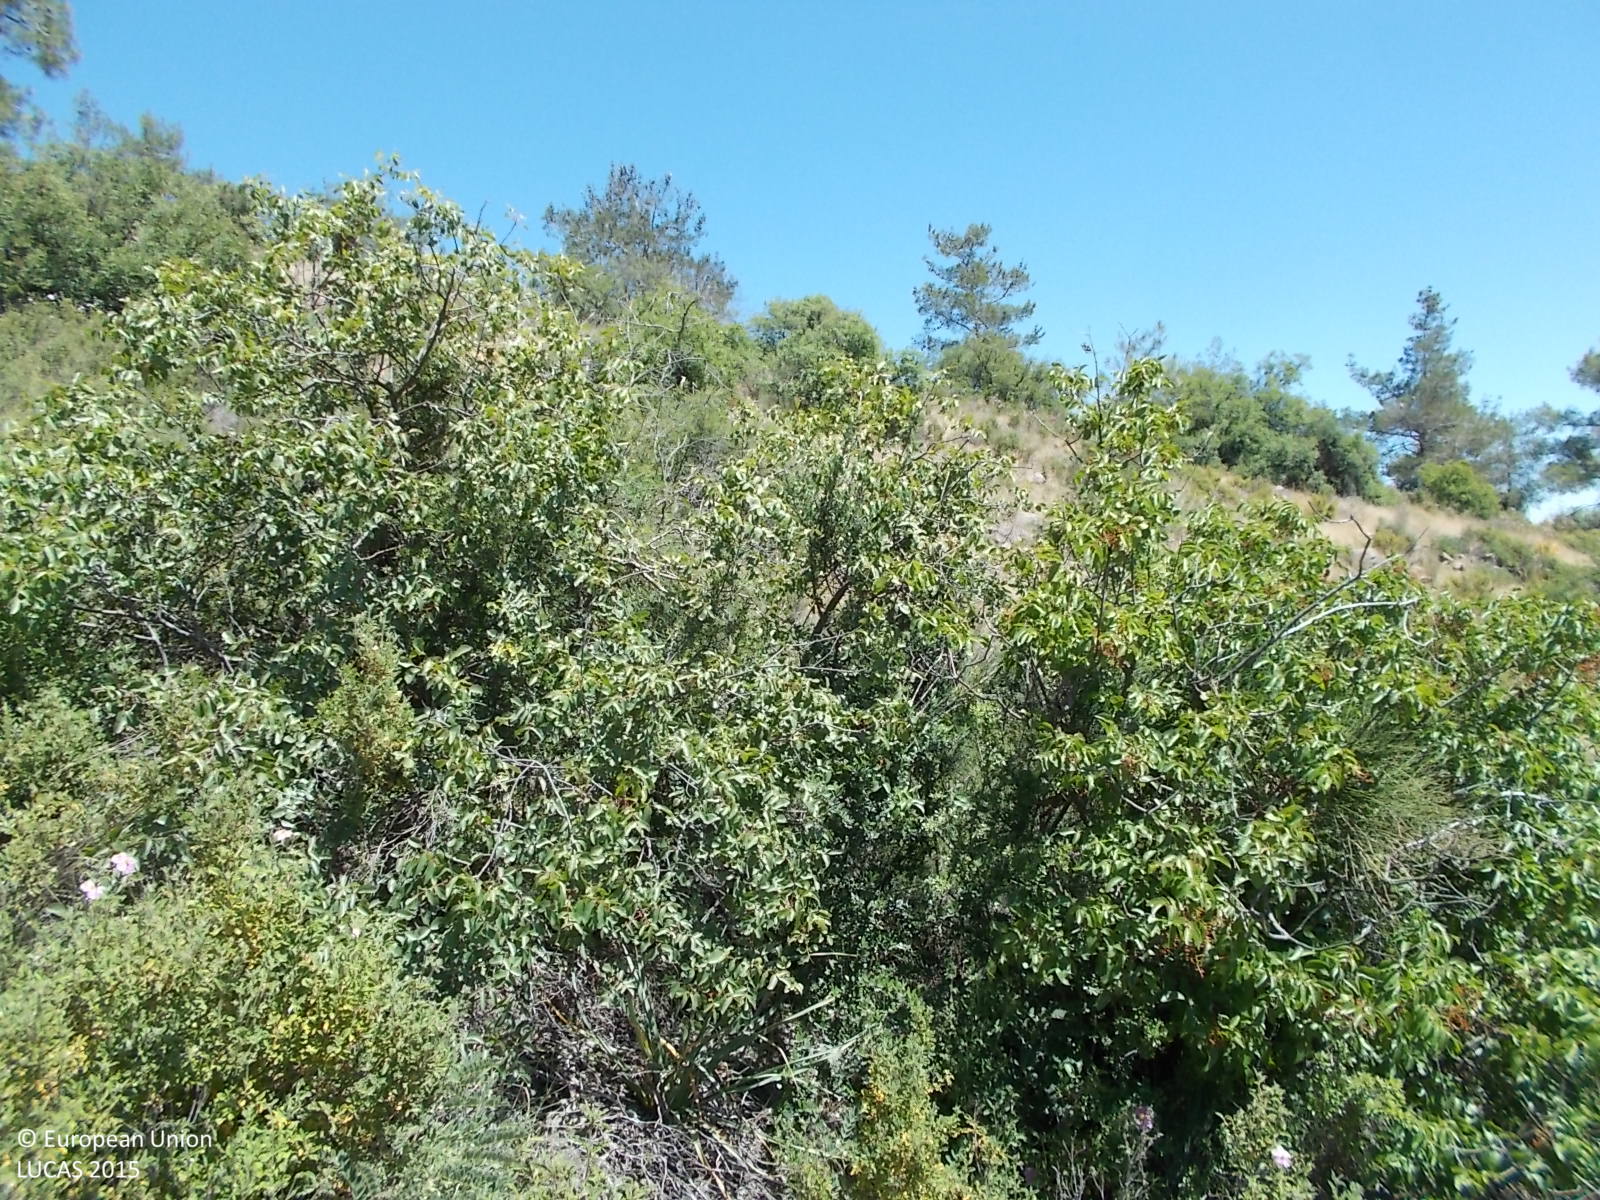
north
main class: Shrubland
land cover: Shrubland with sparse tree cover
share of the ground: > 75 %
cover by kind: shrubs 95 %, broadleaved forest trees 5 %
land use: Semi-natural and natural areas not in use
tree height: < 5 m
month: May
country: CY
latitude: 34.9687
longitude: 33.1233
